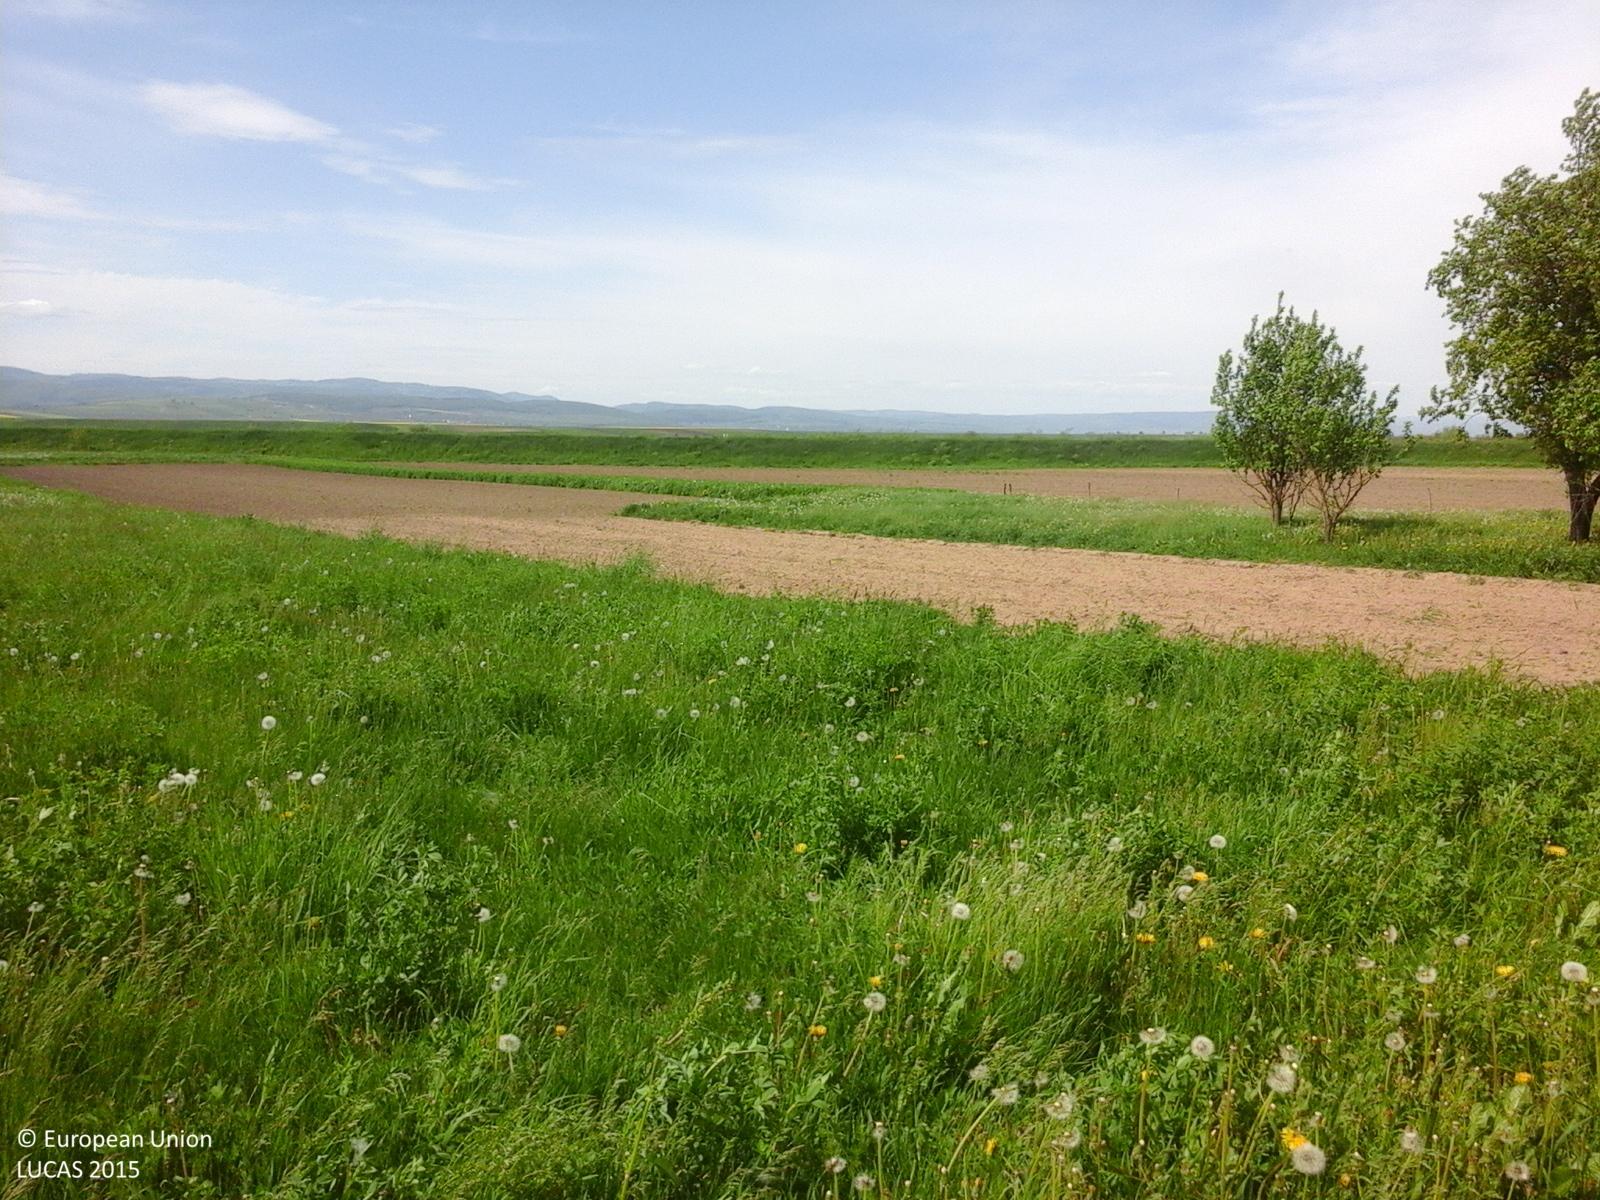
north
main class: Cropland
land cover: Other leguminous and mixtures for fodder
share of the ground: > 75 %
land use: Agriculture (excluding fallow land and kitchen gardens)
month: May
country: RO
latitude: 45.8631
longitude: 26.0506
